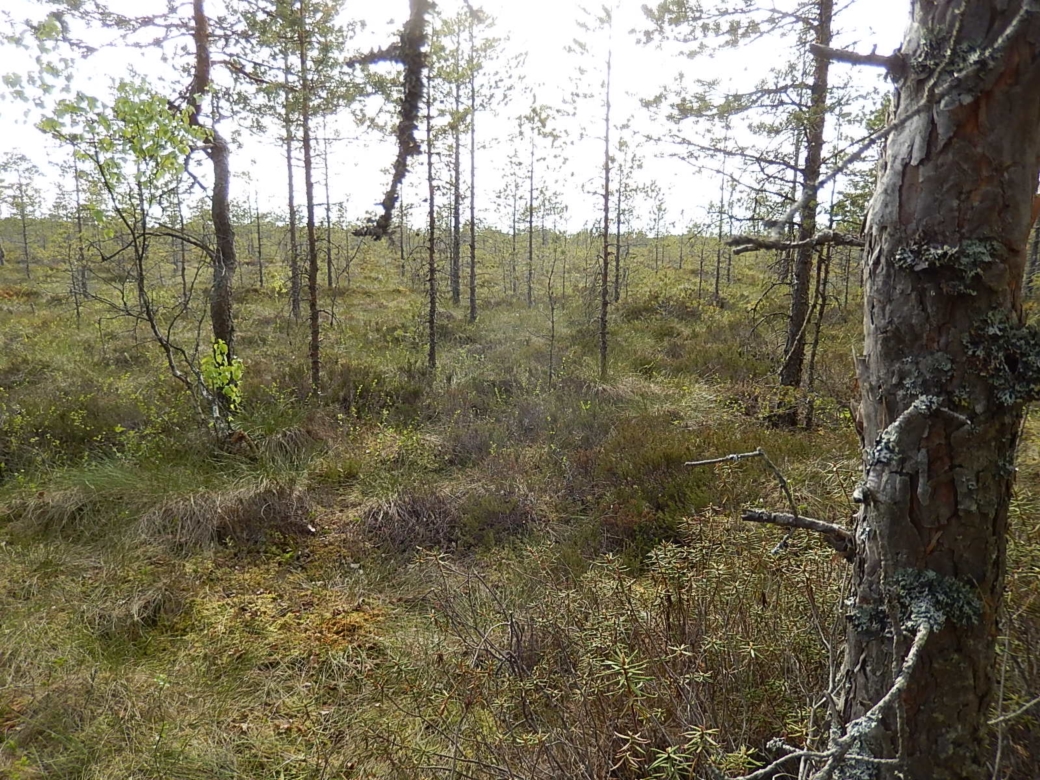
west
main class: Woodland
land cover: Pine dominated mixed woodland
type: boreal forest
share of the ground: > 75 %
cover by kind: coniferous forest trees 50 %, broadleaved forest trees 30 %, shrubs 10 %, herbaceous plants 10 %
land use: Forestry
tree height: > 5 m
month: June
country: FI
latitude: 61.9480
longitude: 21.5418
